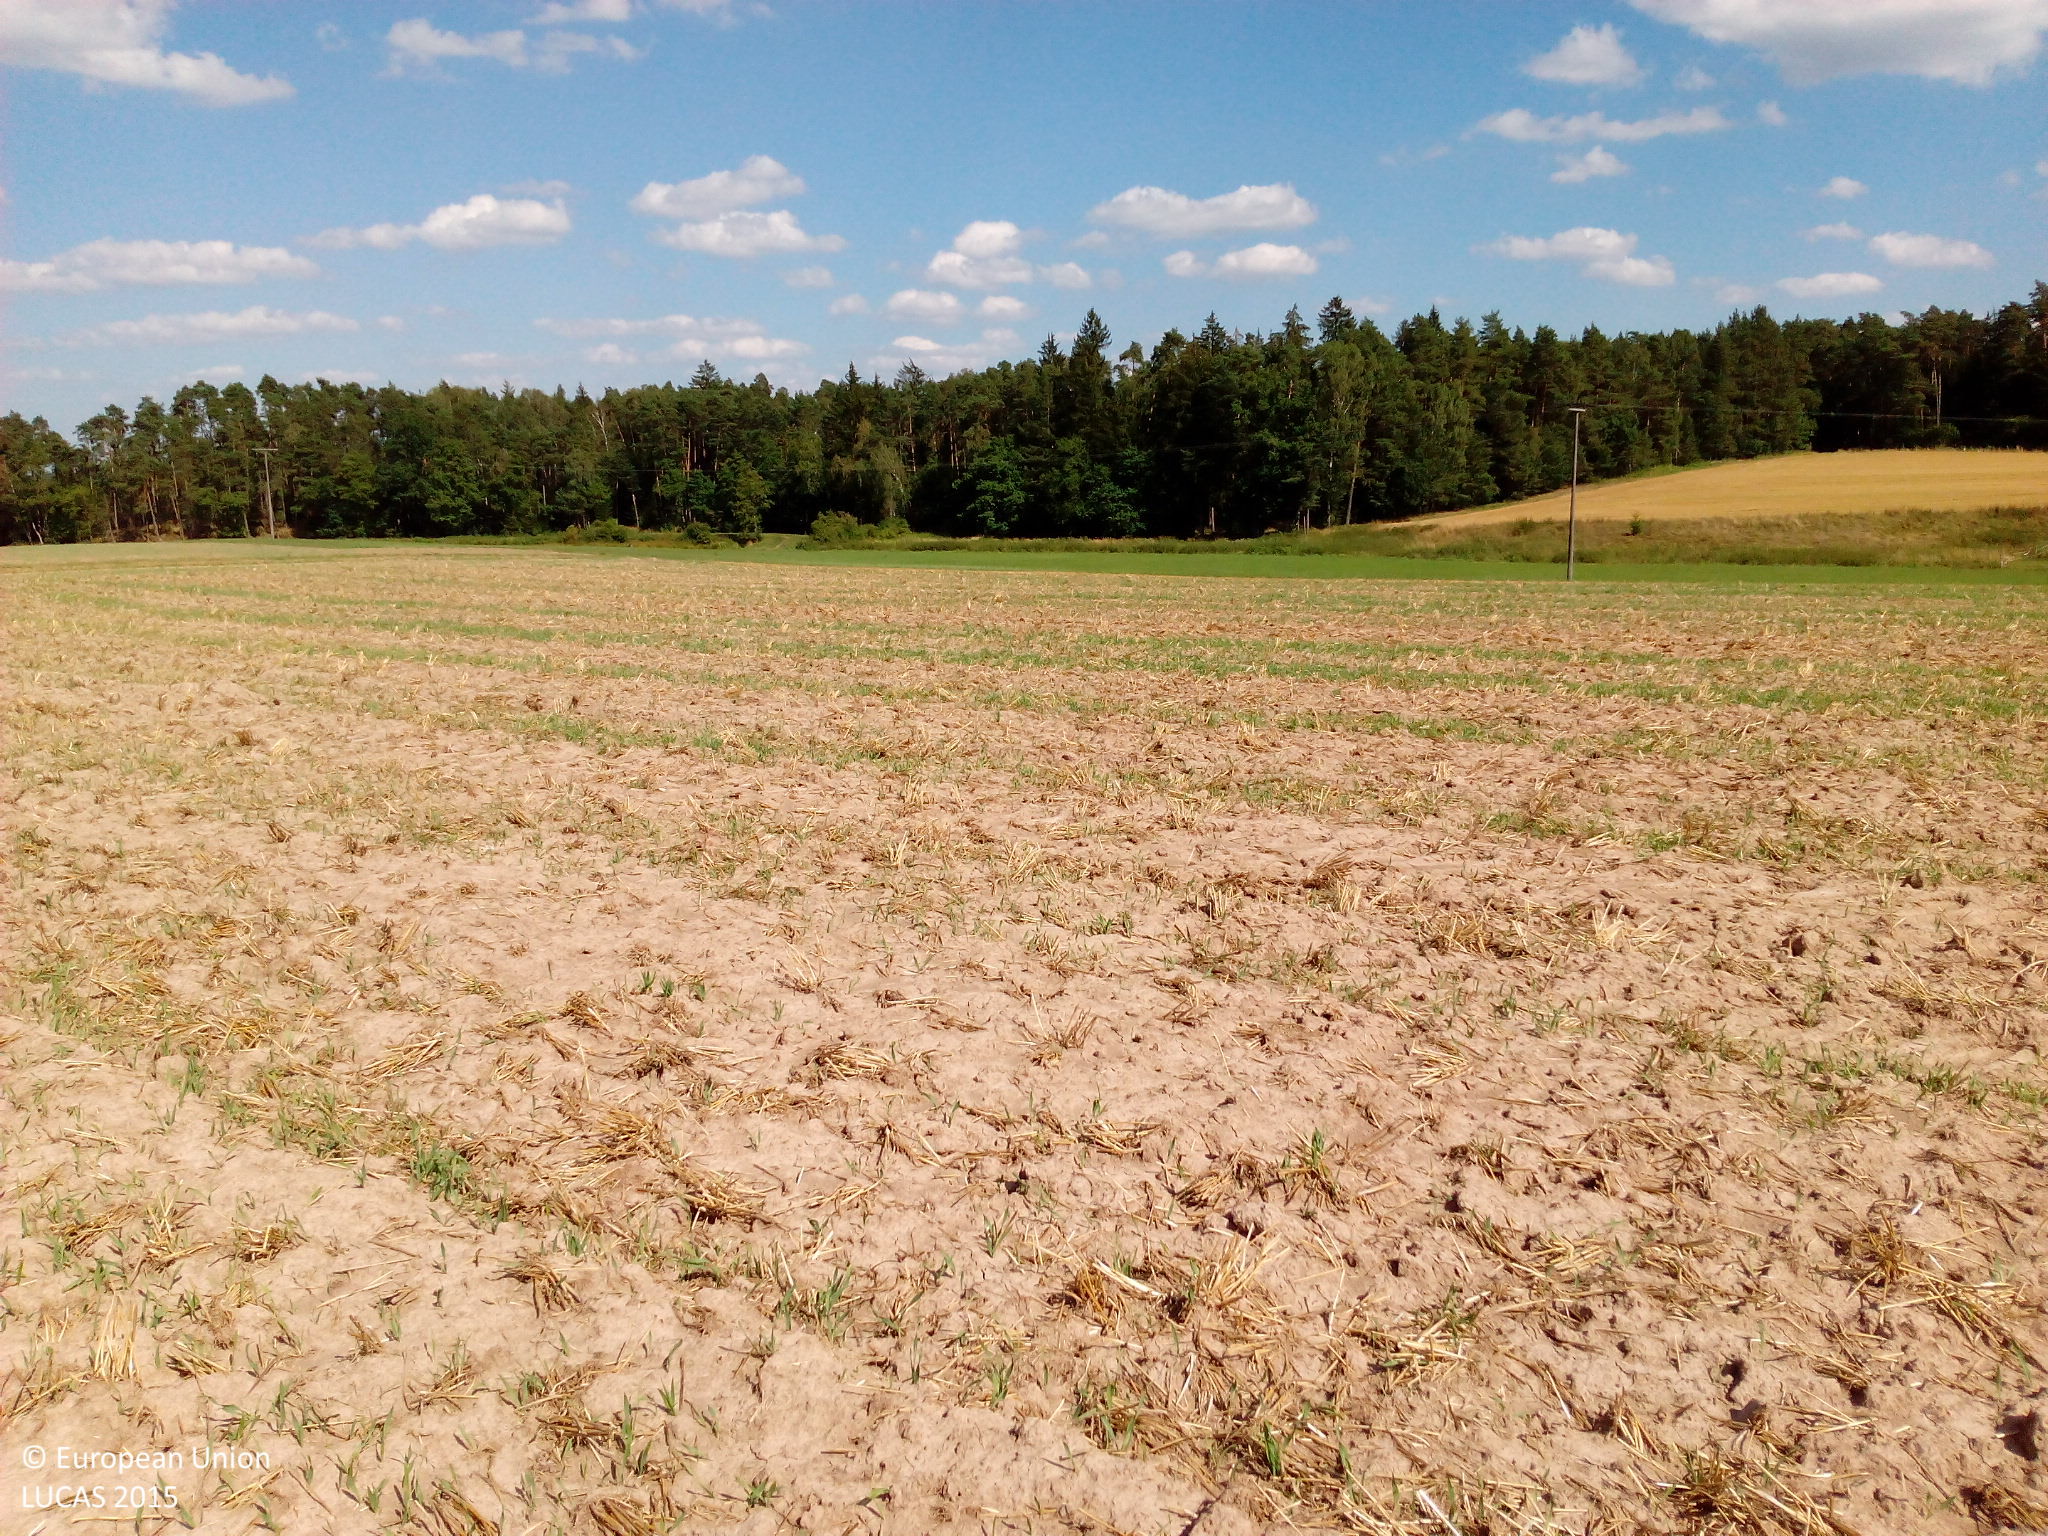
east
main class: Cropland
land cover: Common wheat
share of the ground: < 10 %
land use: Agriculture (excluding fallow land and kitchen gardens)
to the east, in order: Common wheat; Grassland without tree/shrub cover; Electric lines; Grassland without tree/shrub cover; Inland fresh running water; Spontaneously vegetated surfaces
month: August
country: DE
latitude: 49.0147
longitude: 10.3143
